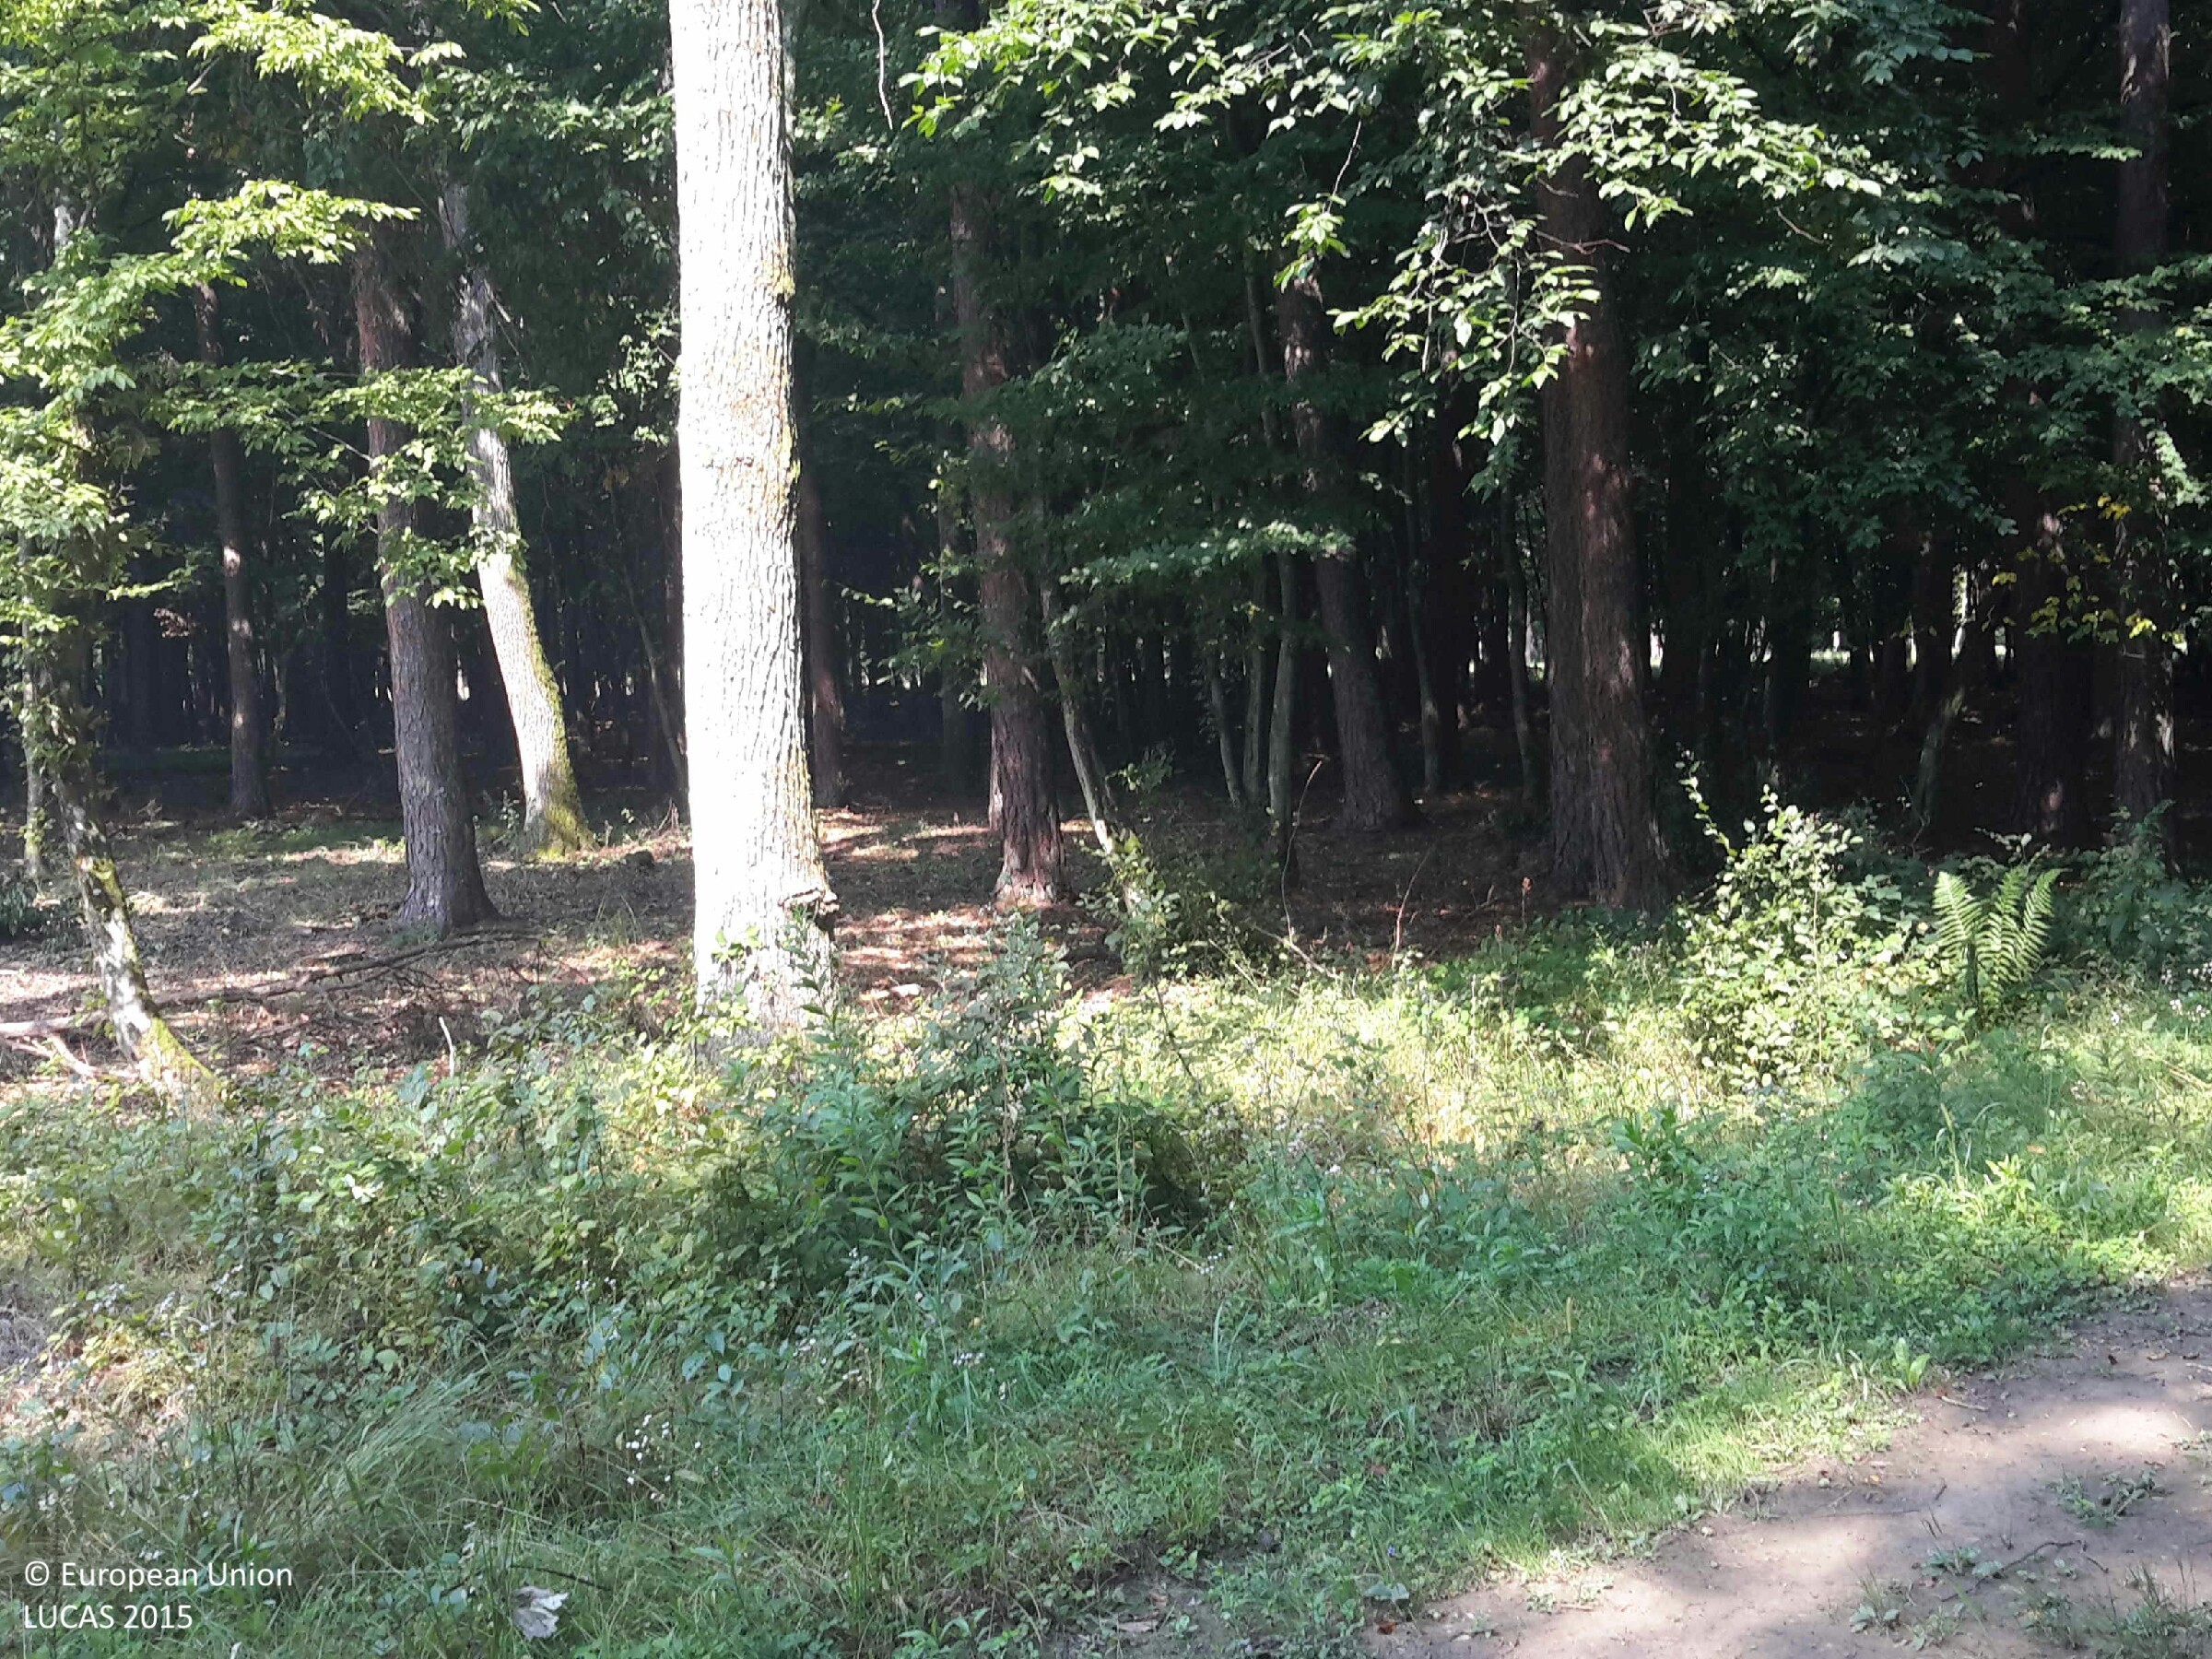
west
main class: Woodland
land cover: Broadleaved woodland
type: beech forest
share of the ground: > 75 %
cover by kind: broadleaved forest trees 90 %, herbaceous plants 10 %
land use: Forestry
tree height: > 5 m
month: August
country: HU
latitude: 47.1093
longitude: 16.5260
